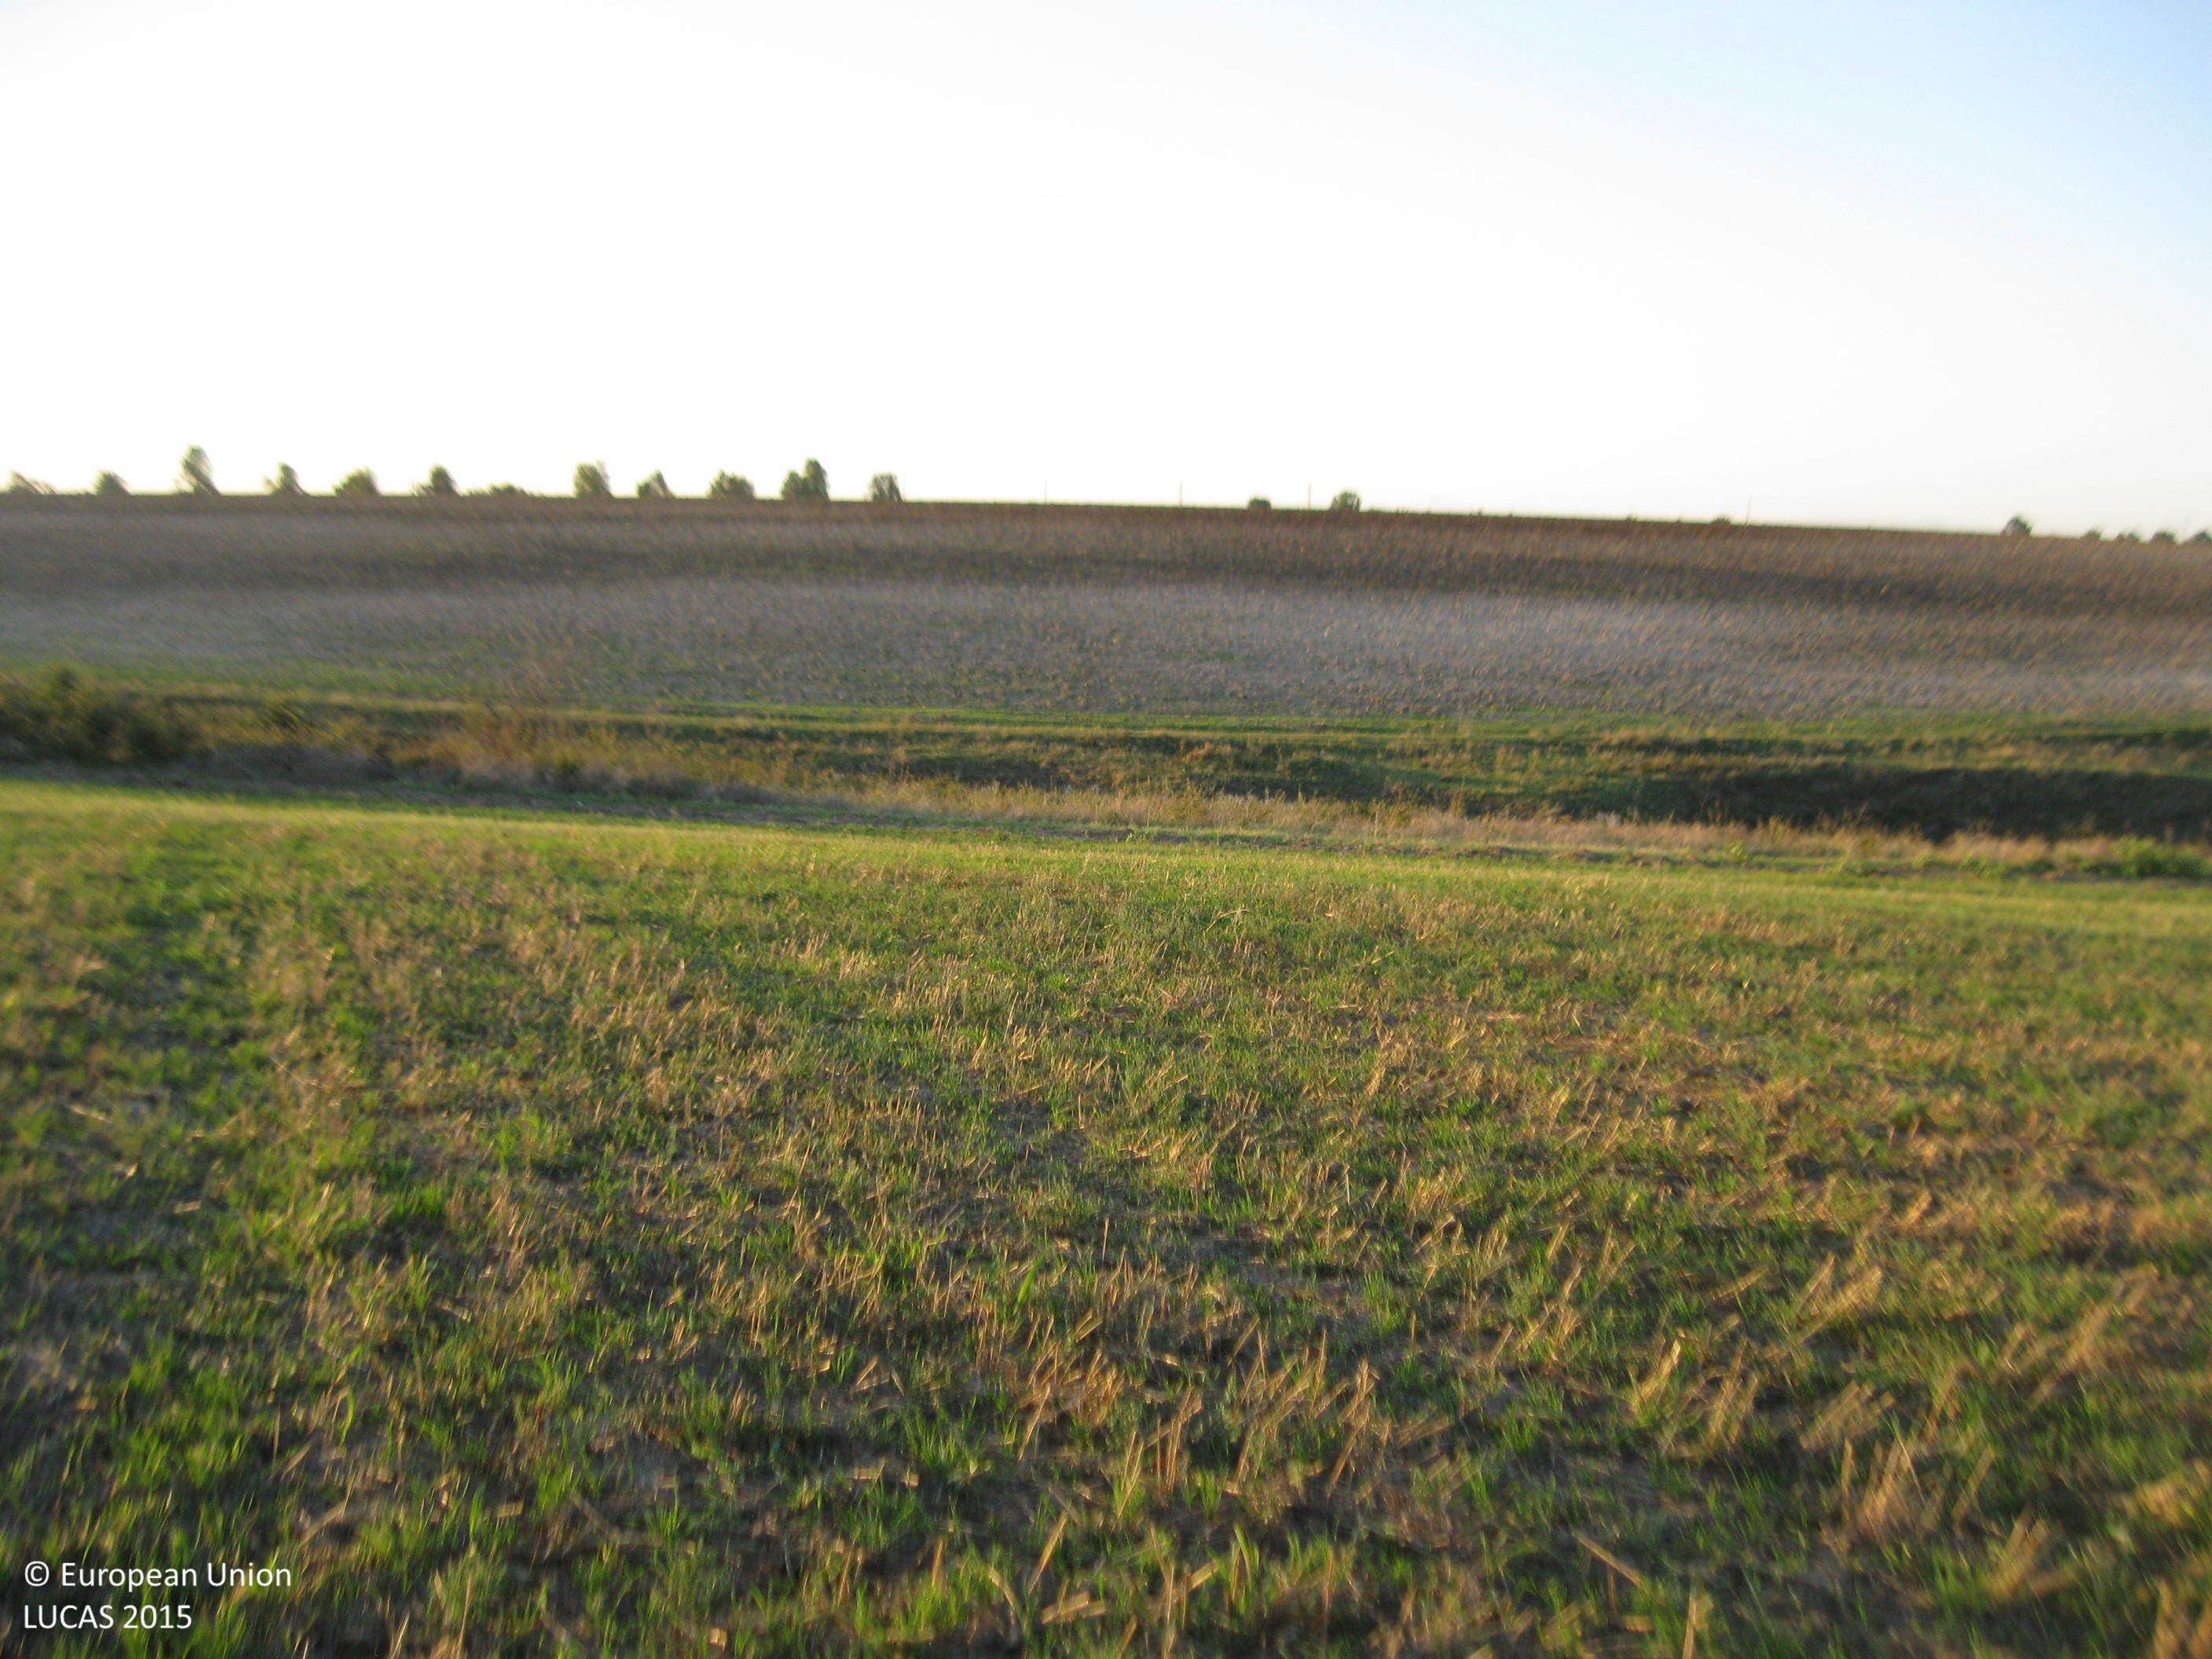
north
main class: Cropland
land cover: Common wheat
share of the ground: 25 - 50 %
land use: Agriculture (excluding fallow land and kitchen gardens)
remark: Harvested field
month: September
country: BG
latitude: 42.0963
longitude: 25.0123
